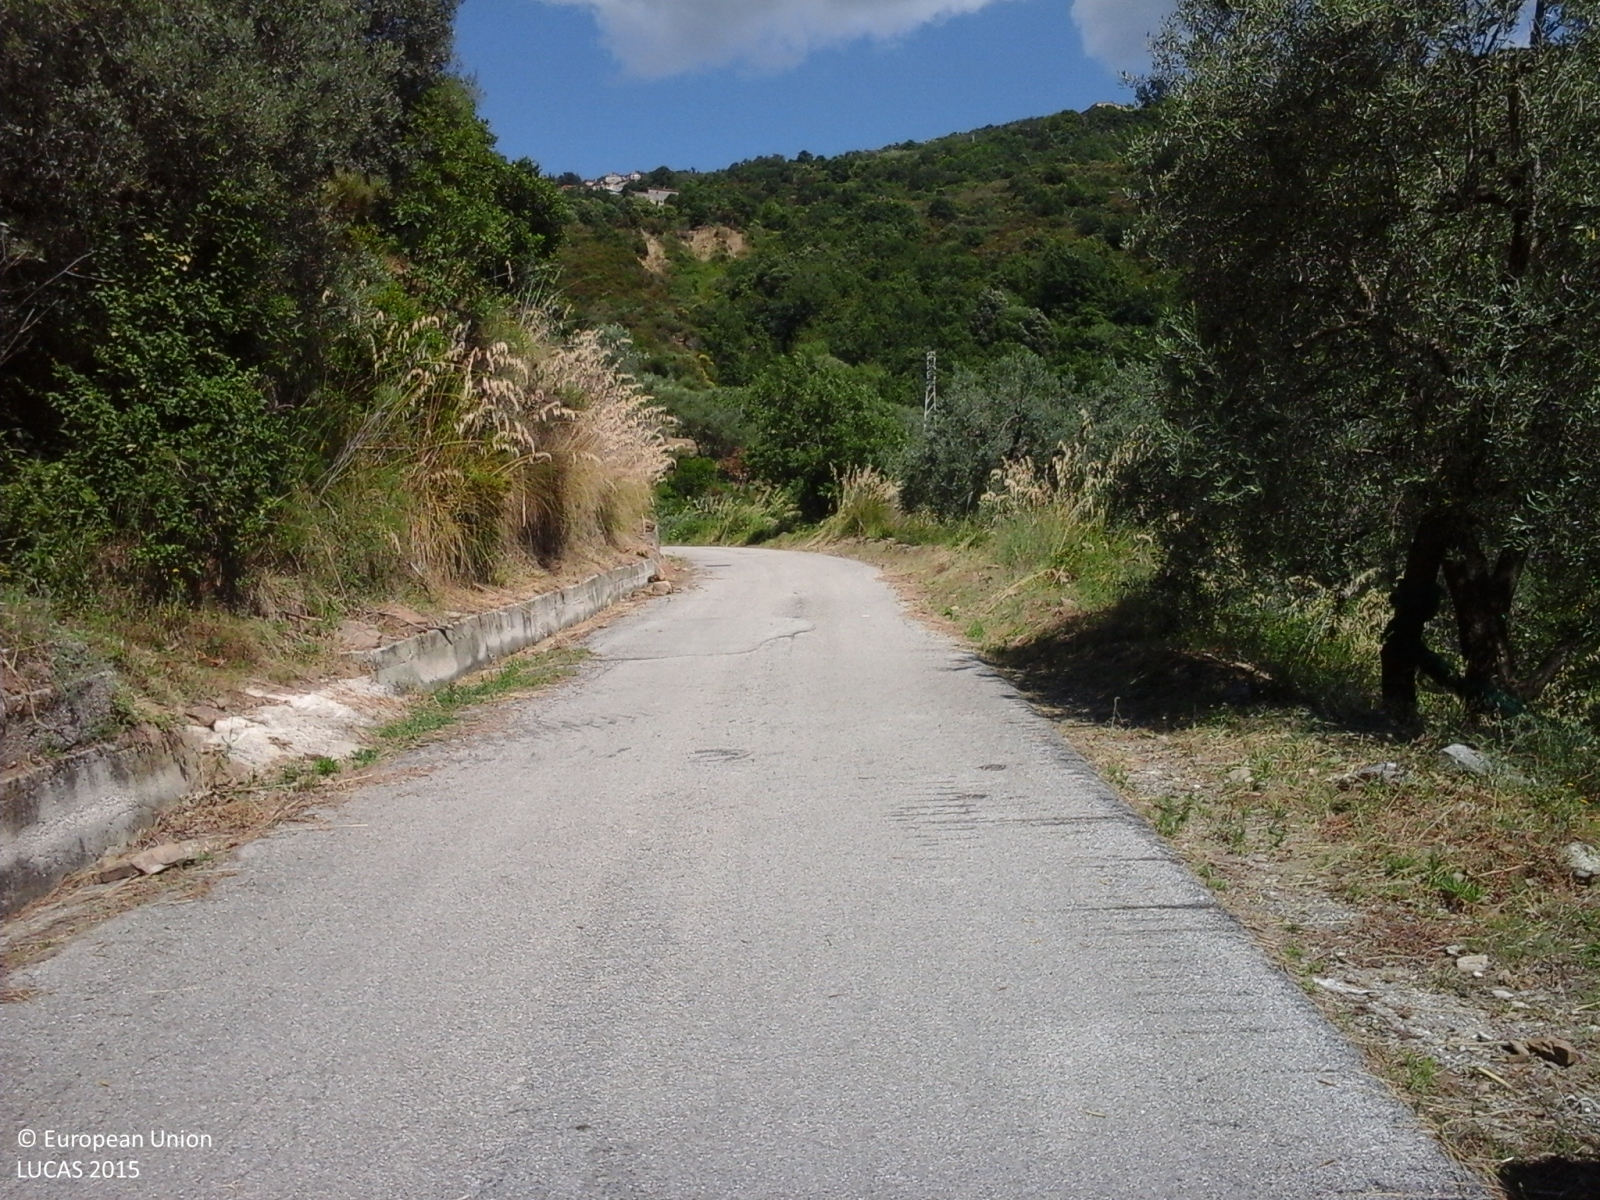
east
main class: Shrubland
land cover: Shrubland with sparse tree cover
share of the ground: > 75 %
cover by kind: shrubs 95 %, broadleaved forest trees 5 %
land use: Semi-natural and natural areas not in use
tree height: > 5 m
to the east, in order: Shrubland with sparse tree cover; Broadleaved woodland; Shrubland with sparse tree cover
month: June
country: IT
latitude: 40.2475
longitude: 15.0208
